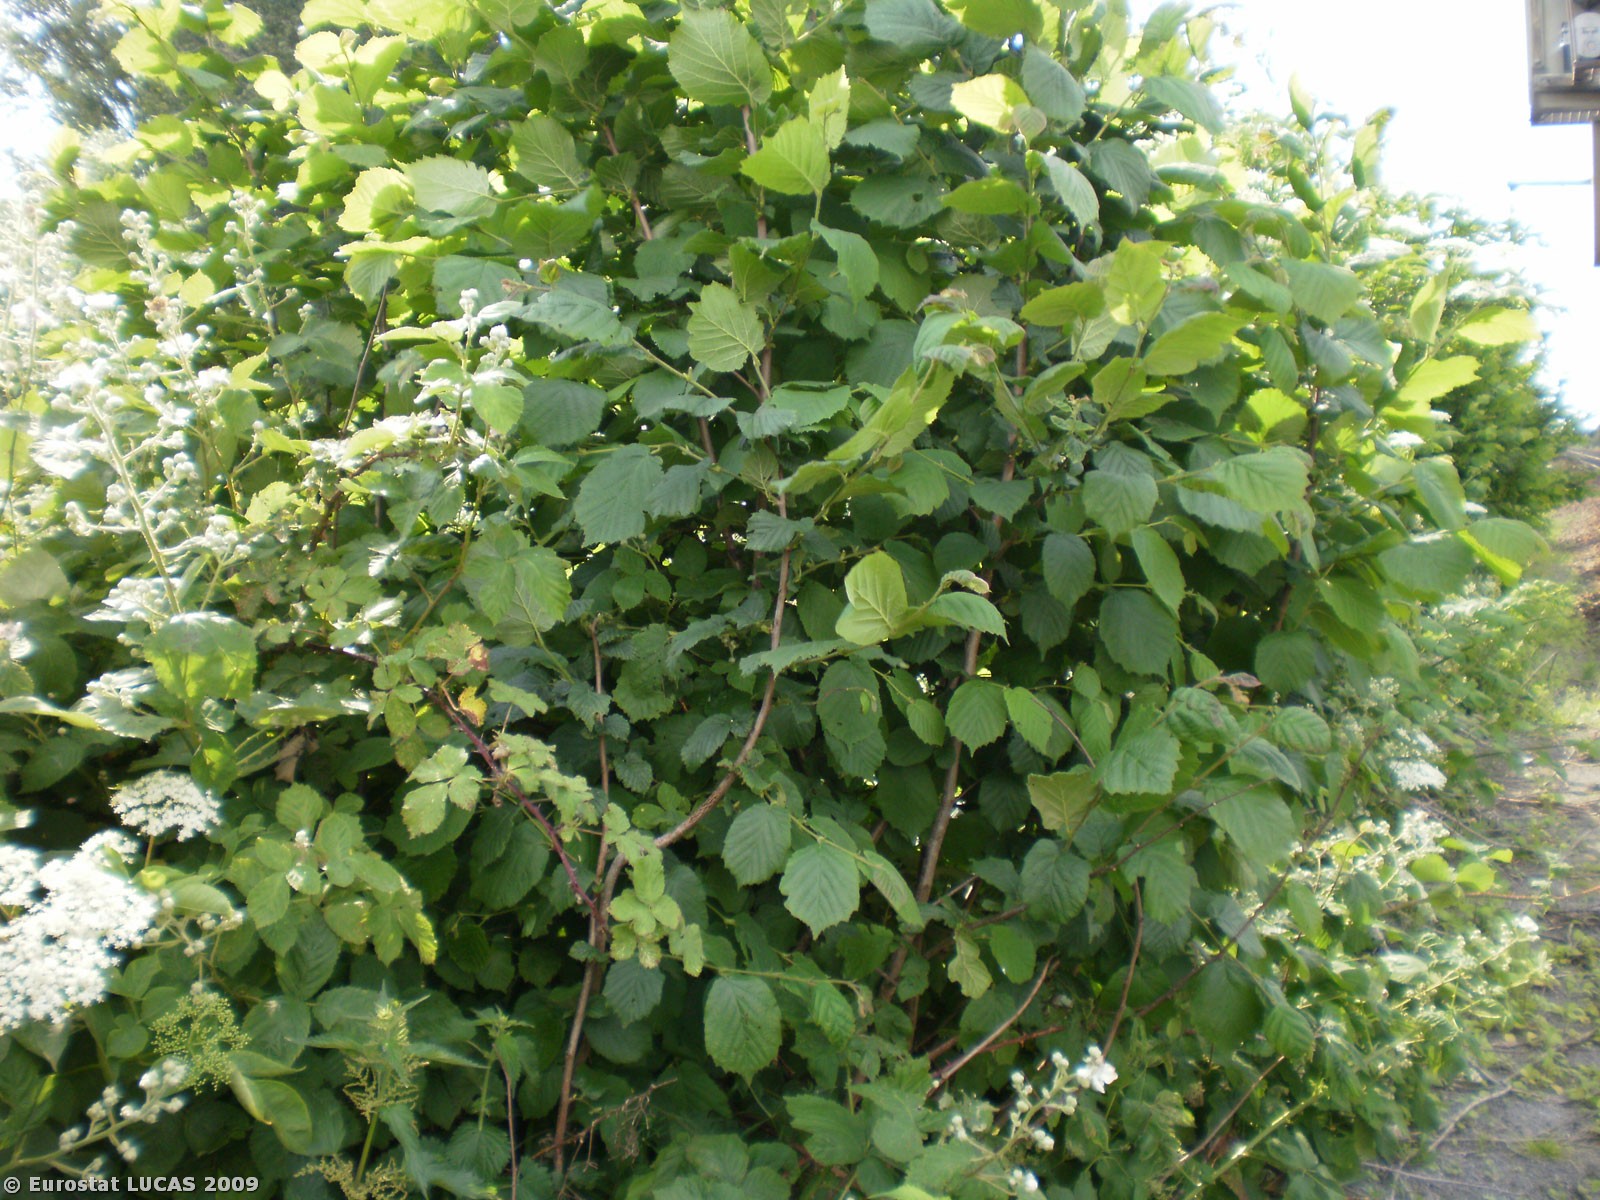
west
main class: Shrubland
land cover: Shrubland without tree cover
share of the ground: > 75 %
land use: Unused
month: June
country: BE
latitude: 50.5952
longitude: 3.8485
